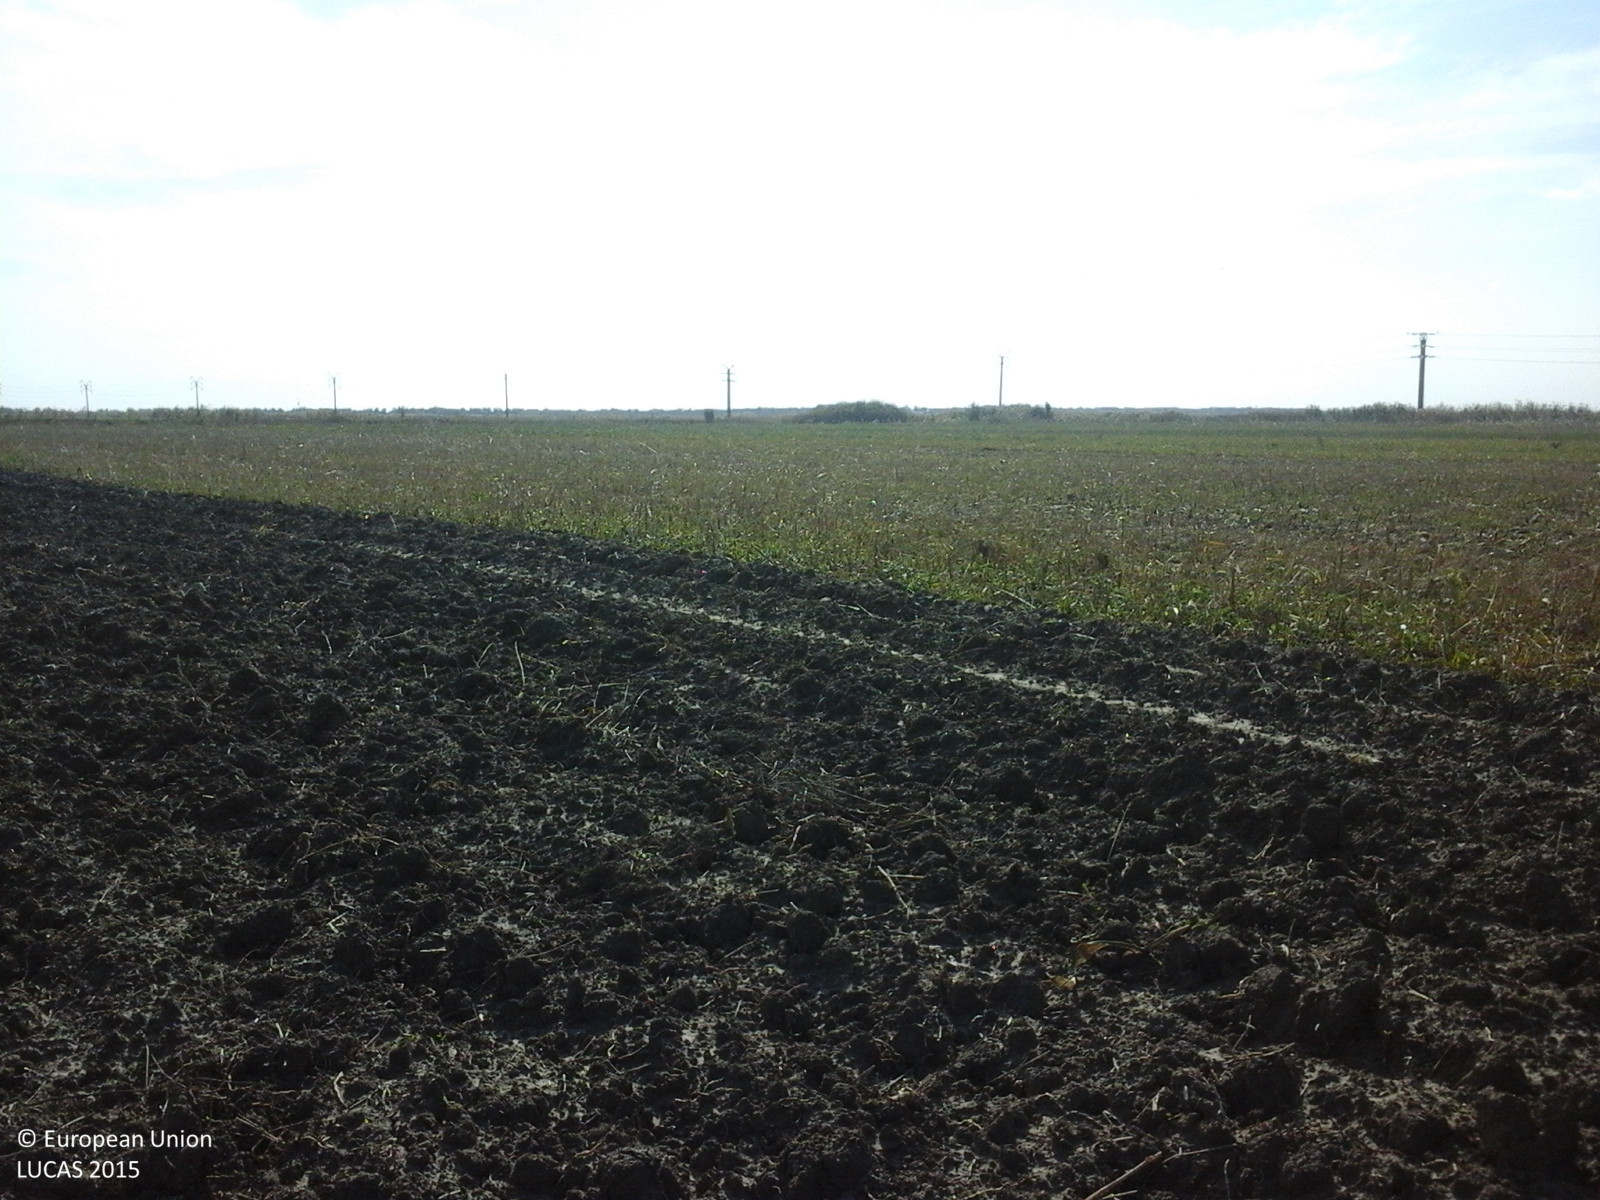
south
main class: Cropland
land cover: Maize
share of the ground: < 10 %
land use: Agriculture (excluding fallow land and kitchen gardens)
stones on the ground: < 10 %
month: October
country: RO
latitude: 45.4934
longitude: 27.4393
